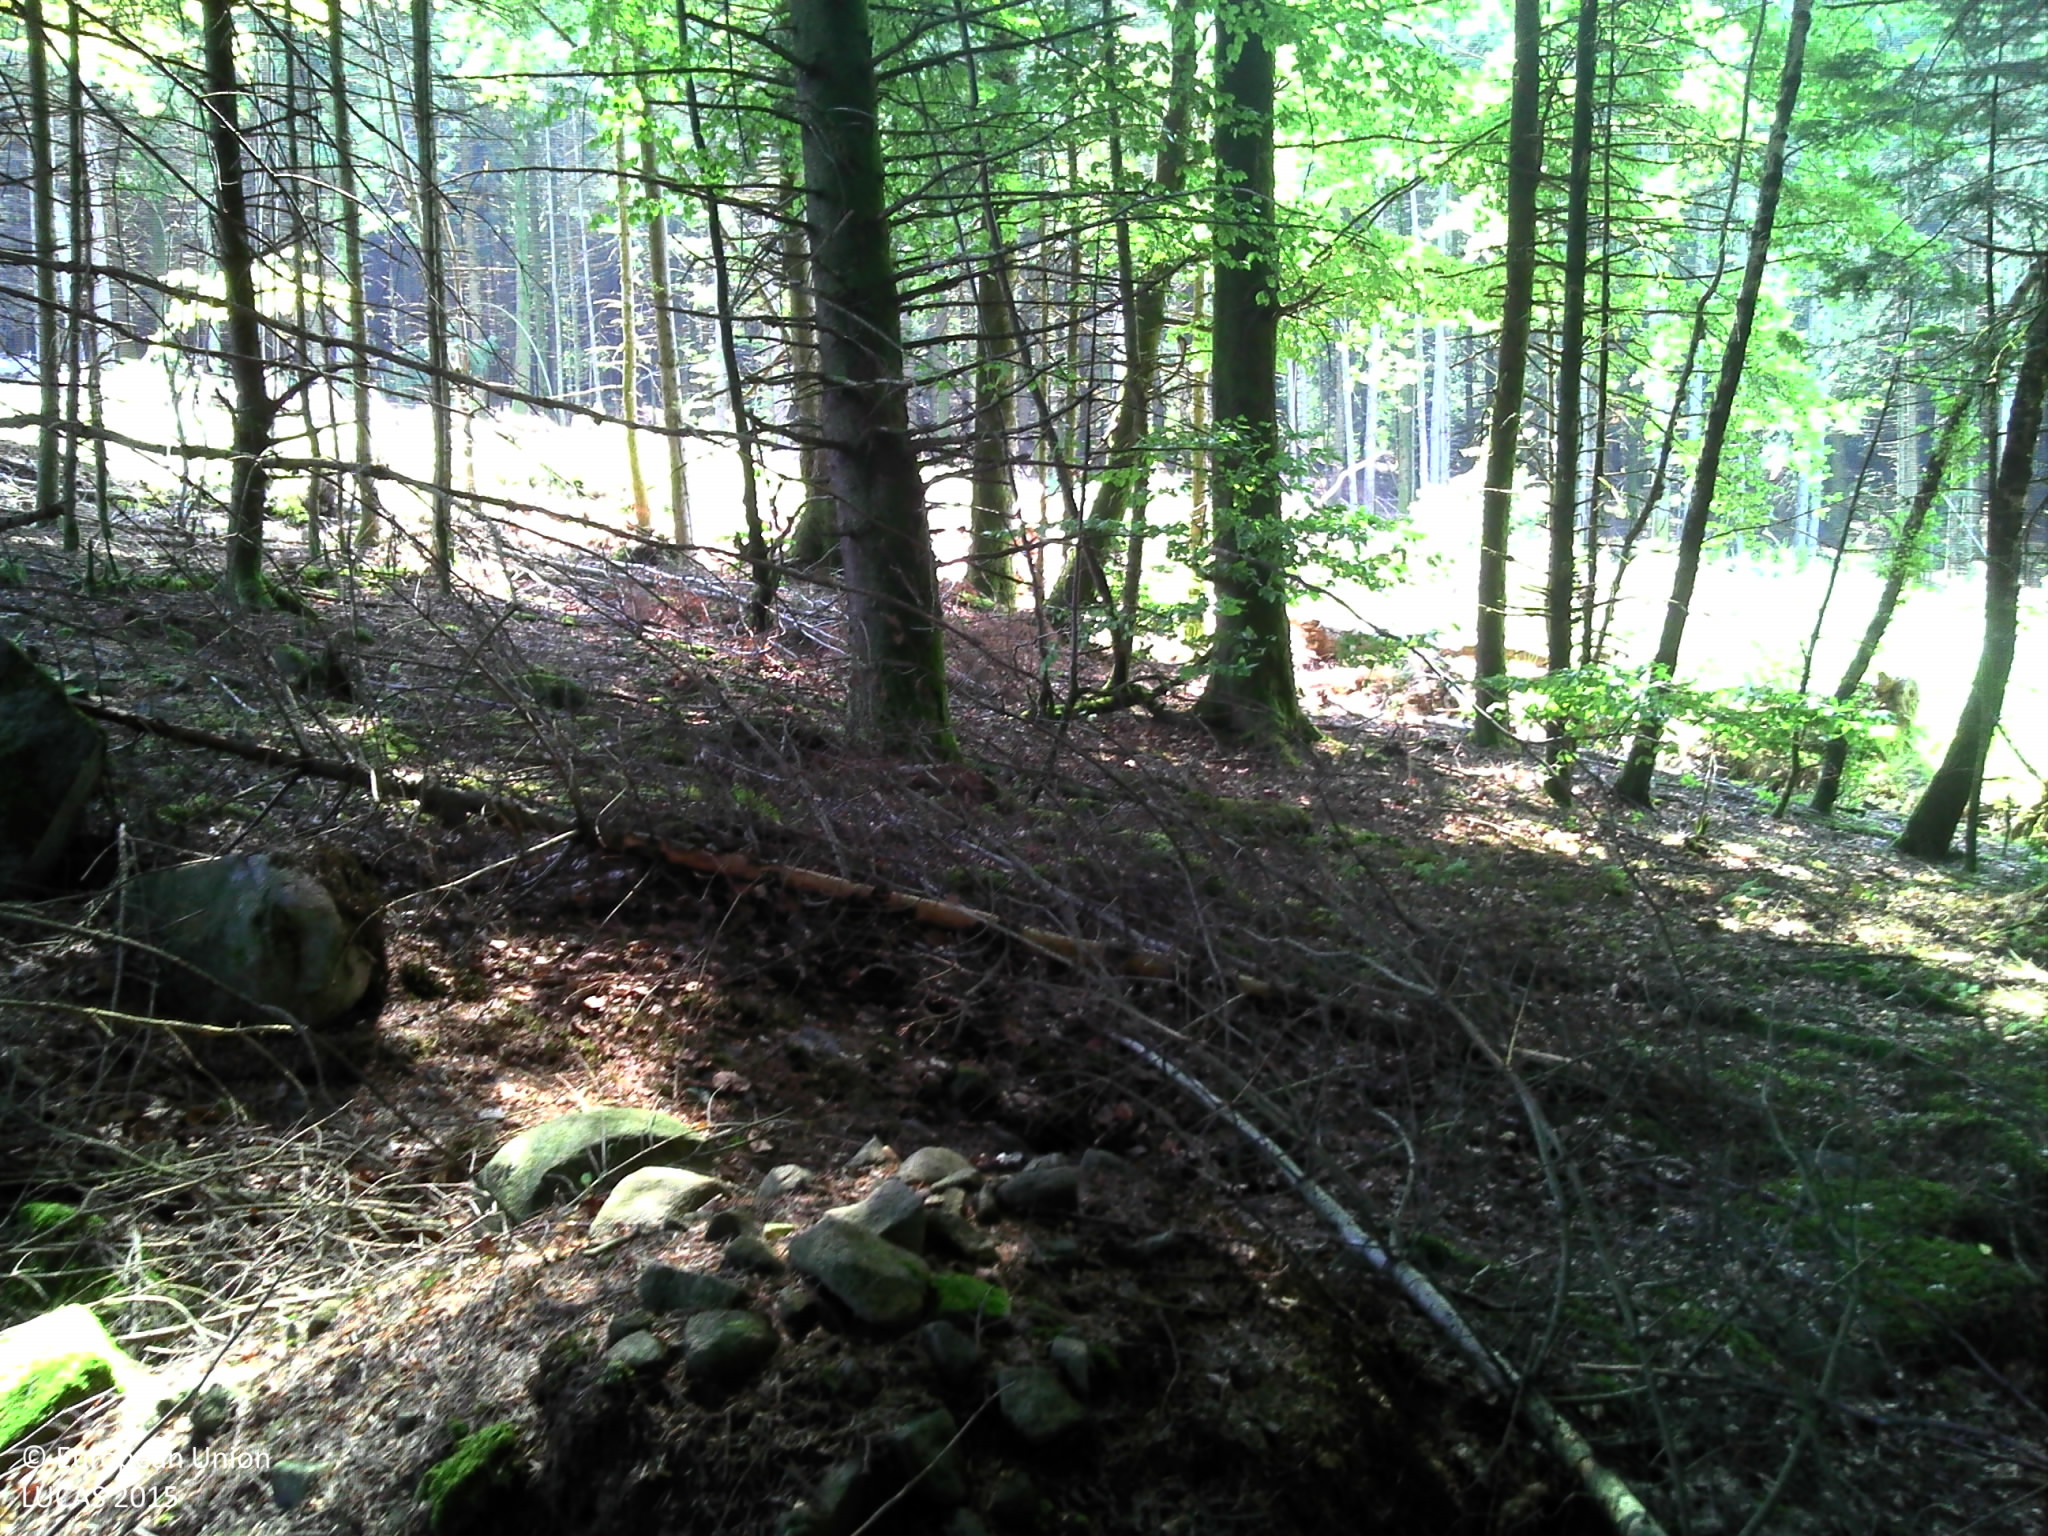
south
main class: Woodland
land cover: Spruce dominated coniferous woodland
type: hemiboreal forest and nemoral coniferous forest and mixed broadleaved-coniferous forest
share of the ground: > 75 %
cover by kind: coniferous forest trees 80 %, herbaceous plants 10 %, lichens and mosses 10 %
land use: Forestry
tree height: > 5 m
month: August
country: FR
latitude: 46.1708
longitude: 4.4455
